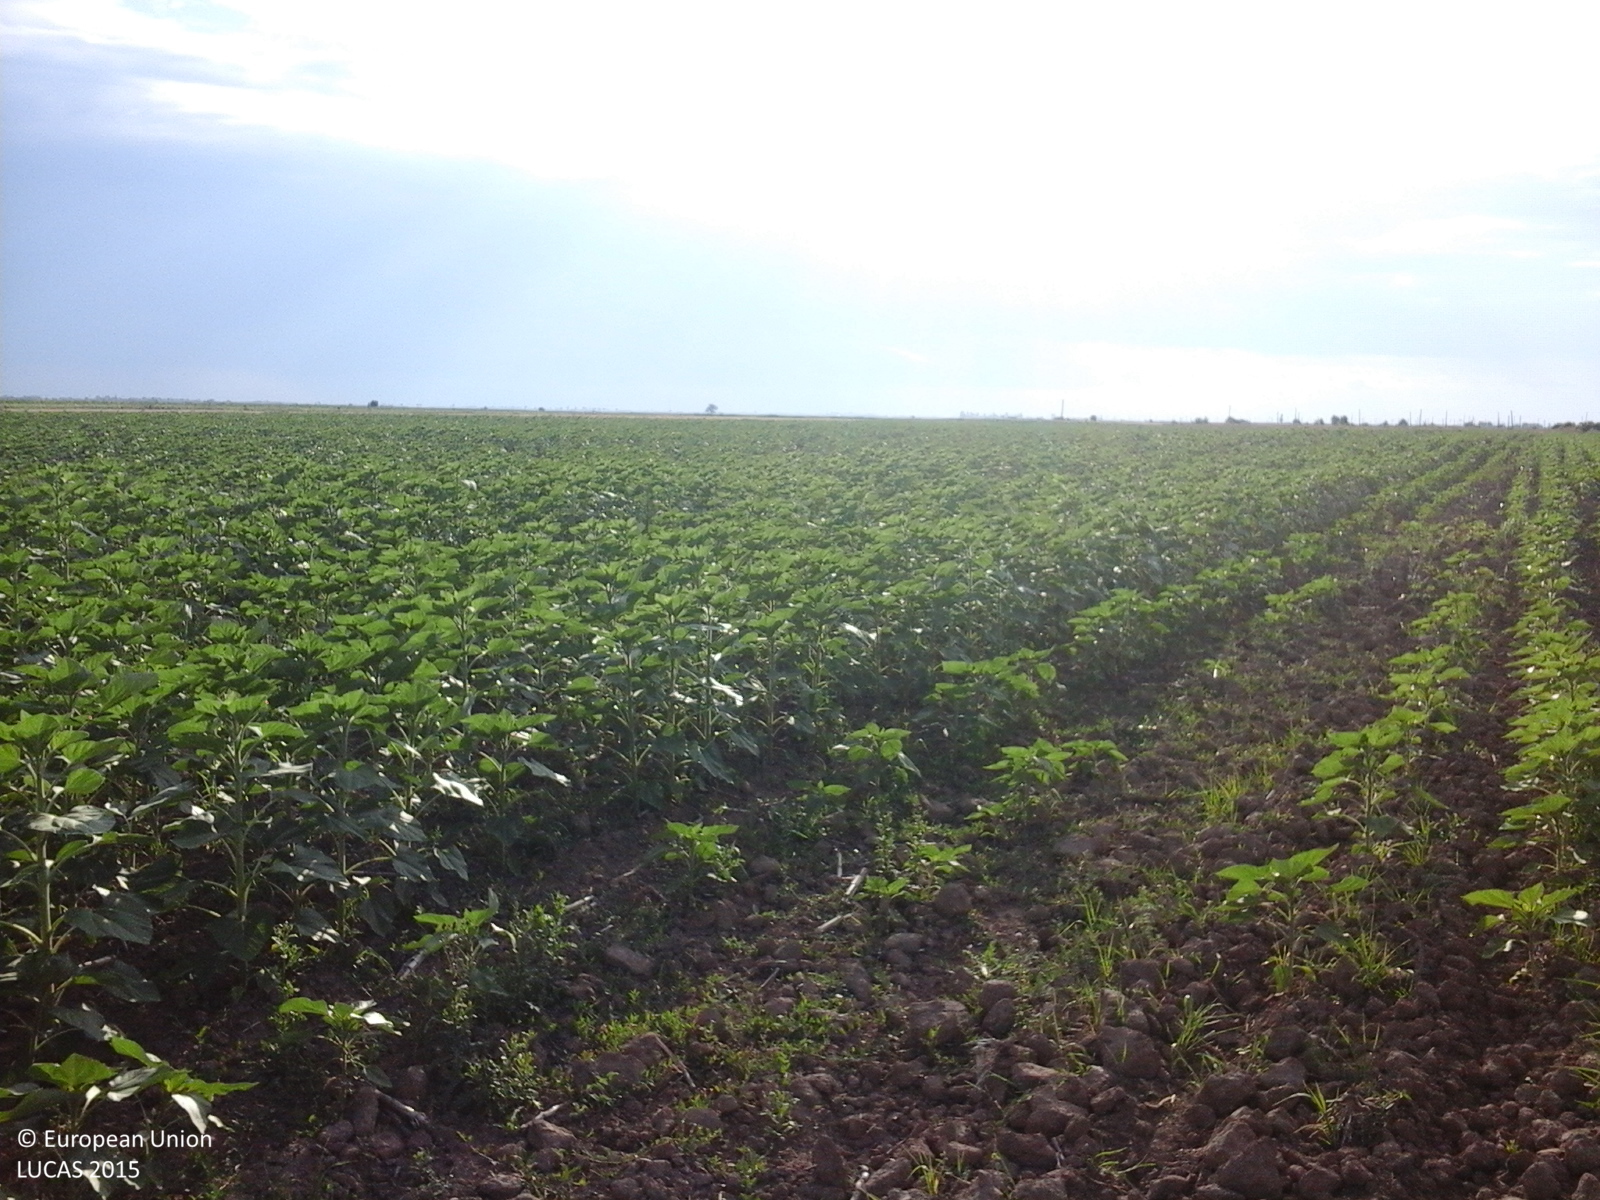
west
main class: Cropland
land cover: Sunflower
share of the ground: 50 - 75 %
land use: Agriculture (excluding fallow land and kitchen gardens)
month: July
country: RO
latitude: 44.3999
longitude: 25.4193
